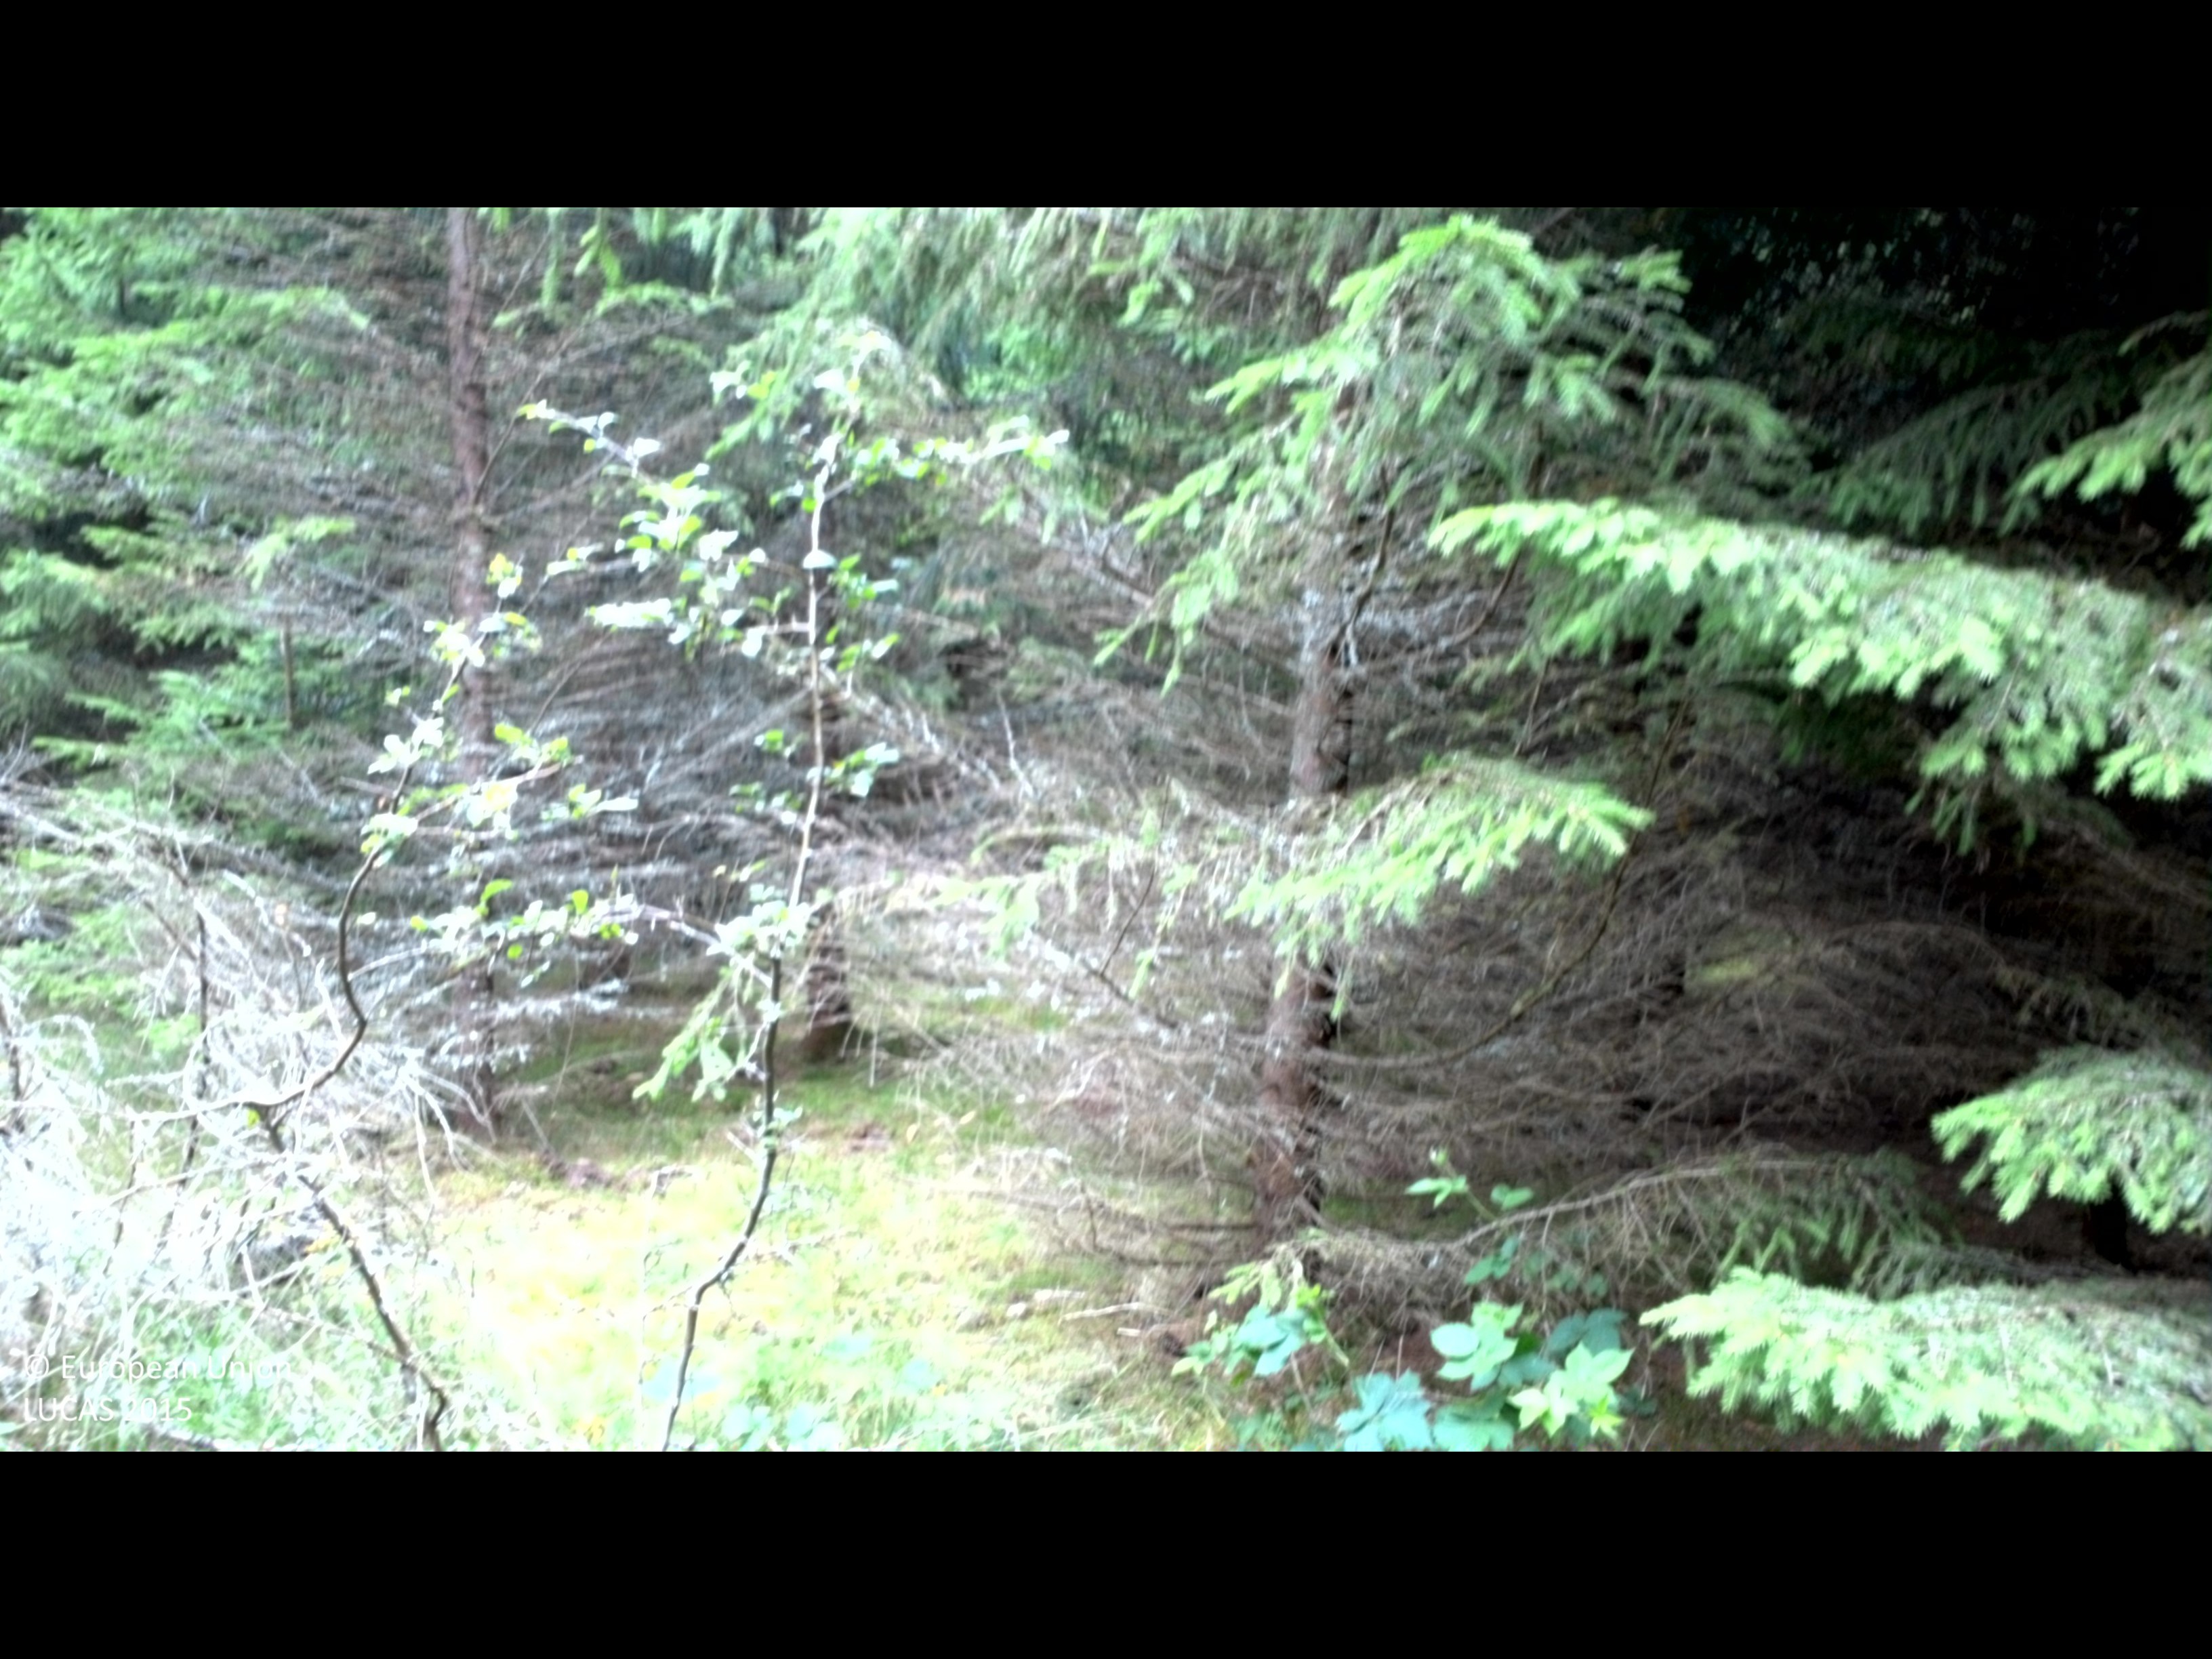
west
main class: Woodland
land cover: Spruce dominated coniferous woodland
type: boreal forest
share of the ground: 50 - 75 %
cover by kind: coniferous forest trees 65 %, lichens and mosses 25 %, broadleaved forest trees 5 %, herbaceous plants 5 %
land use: Forestry
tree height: > 5 m
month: August
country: SE
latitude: 56.3018
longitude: 15.1217
